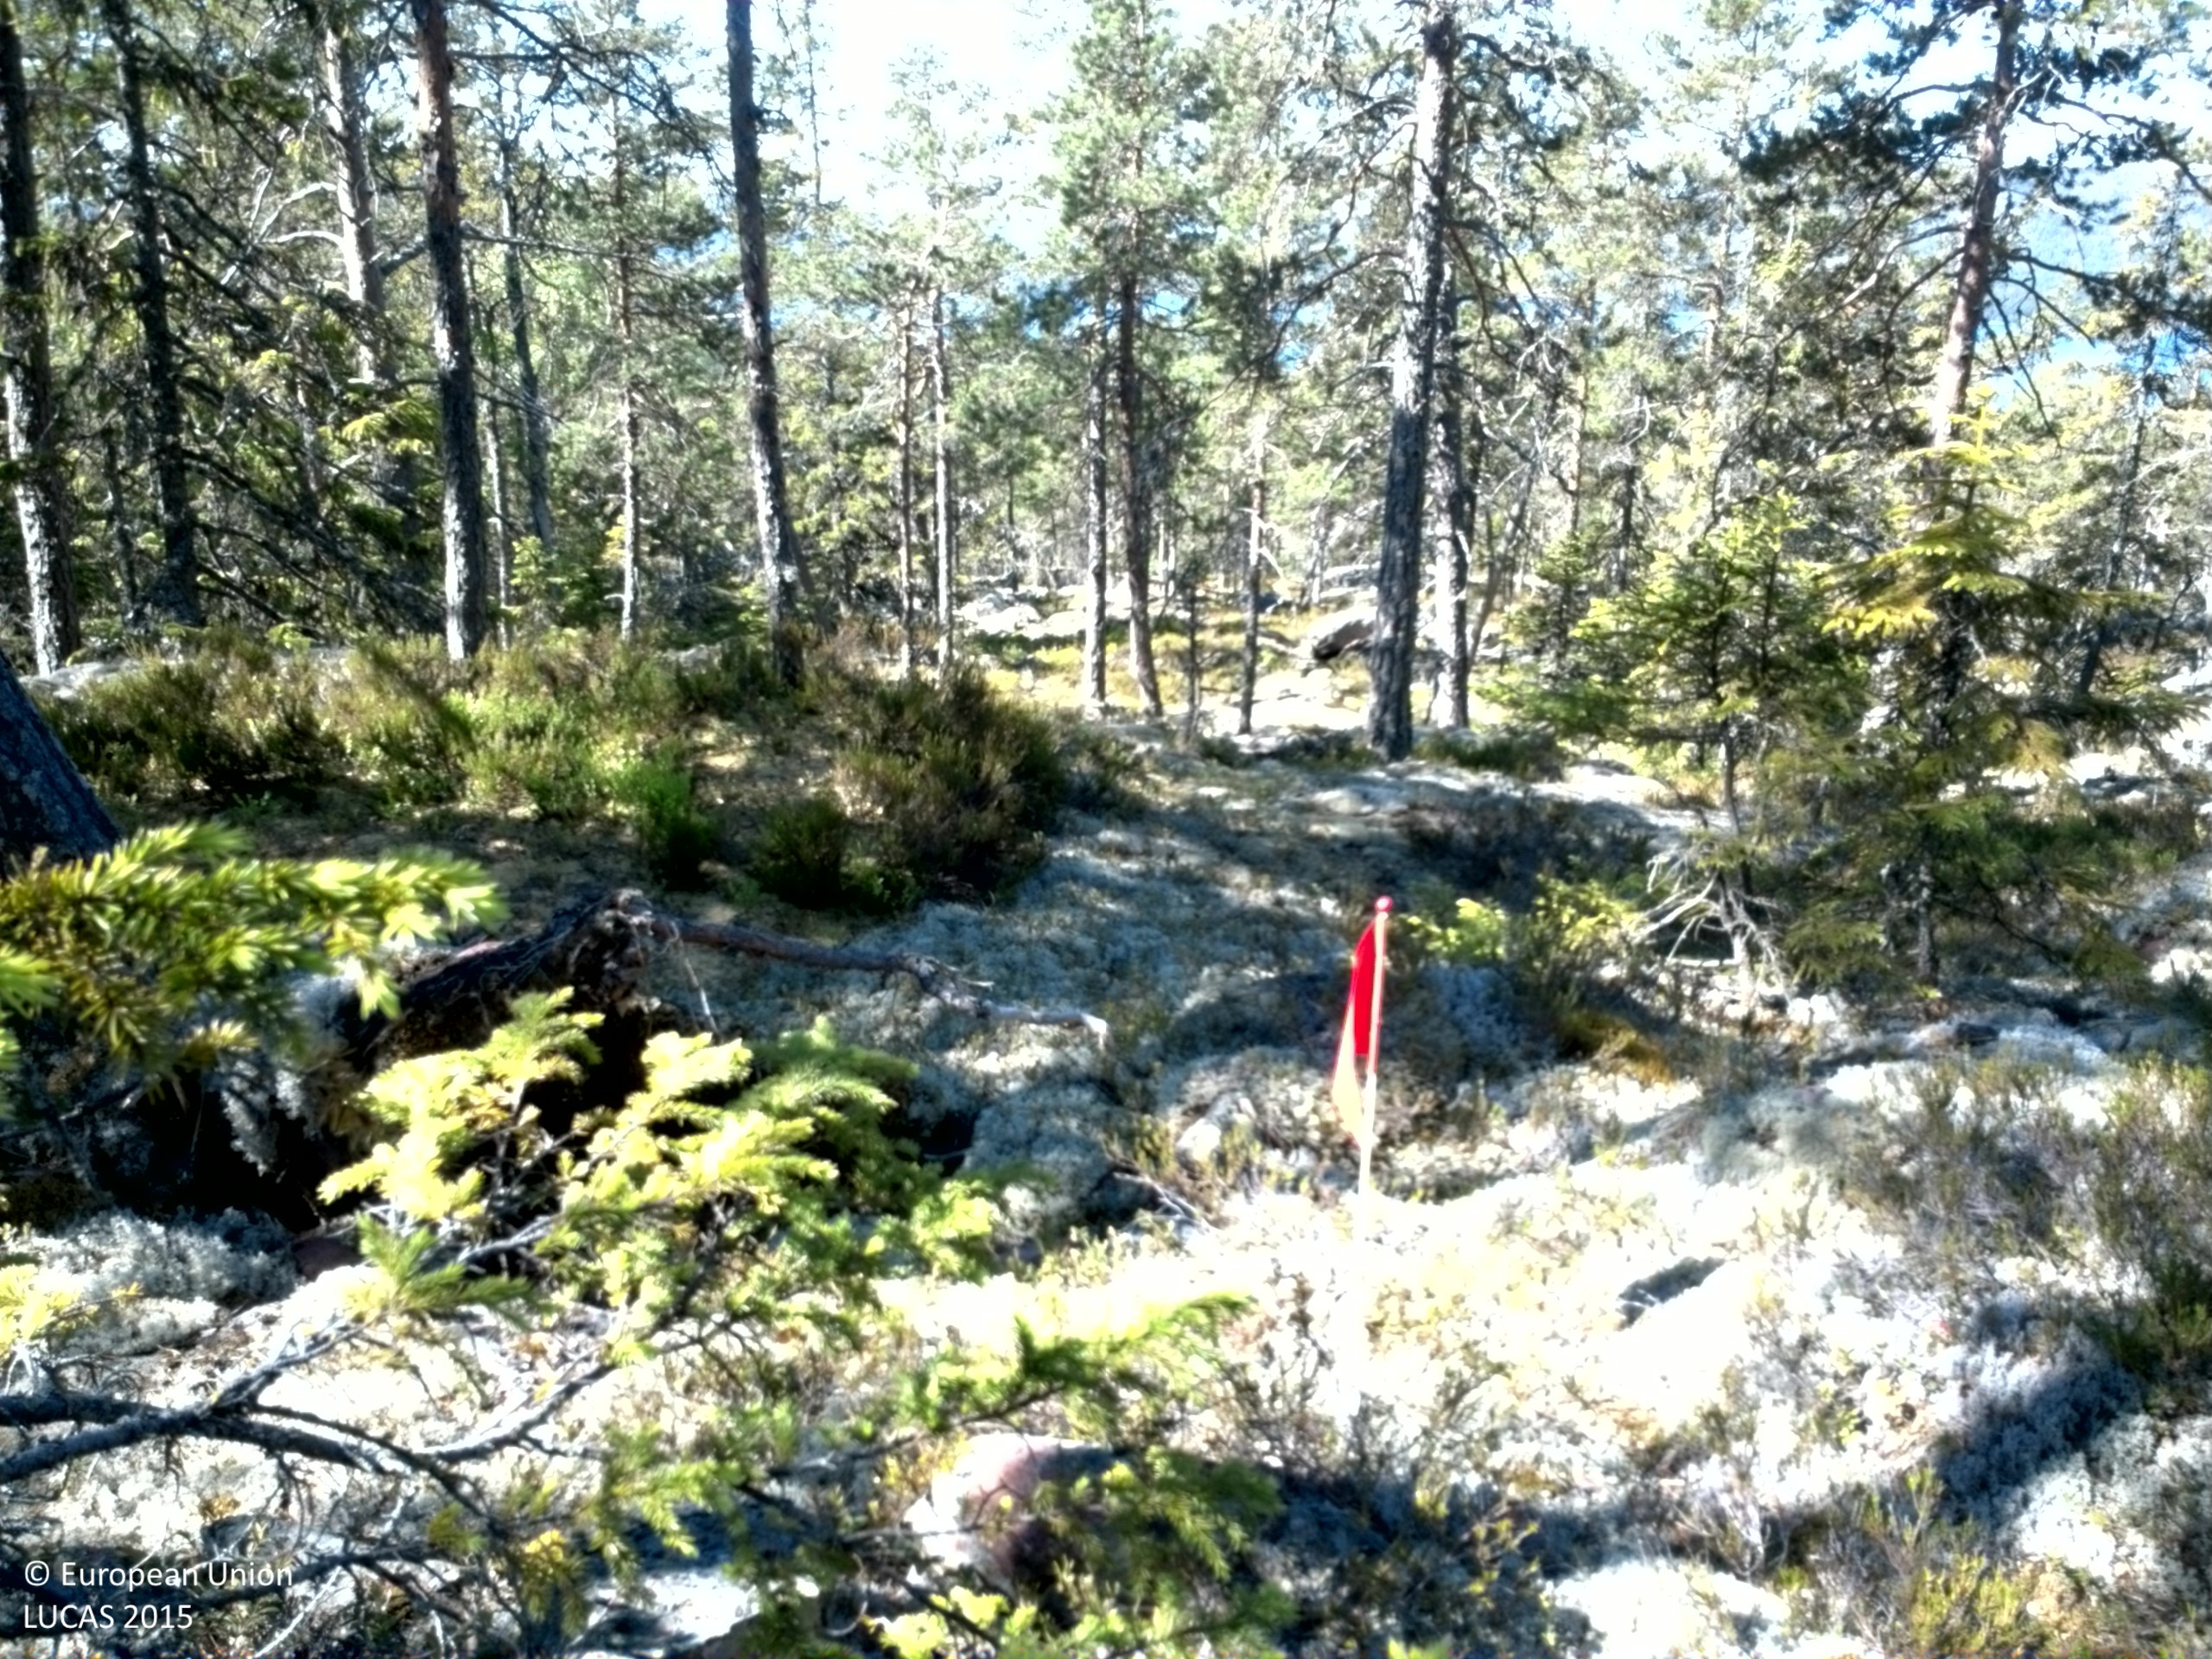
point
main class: Woodland
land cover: Pine dominated coniferous woodland
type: boreal forest
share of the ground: 50 - 75 %
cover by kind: coniferous forest trees 45 %, lichens and mosses 35 %, shrubs 10 %, consolidated bare surface 10 %
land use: Semi-natural and natural areas not in use
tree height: > 5 m
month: June
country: SE
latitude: 63.0457
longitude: 18.4624
